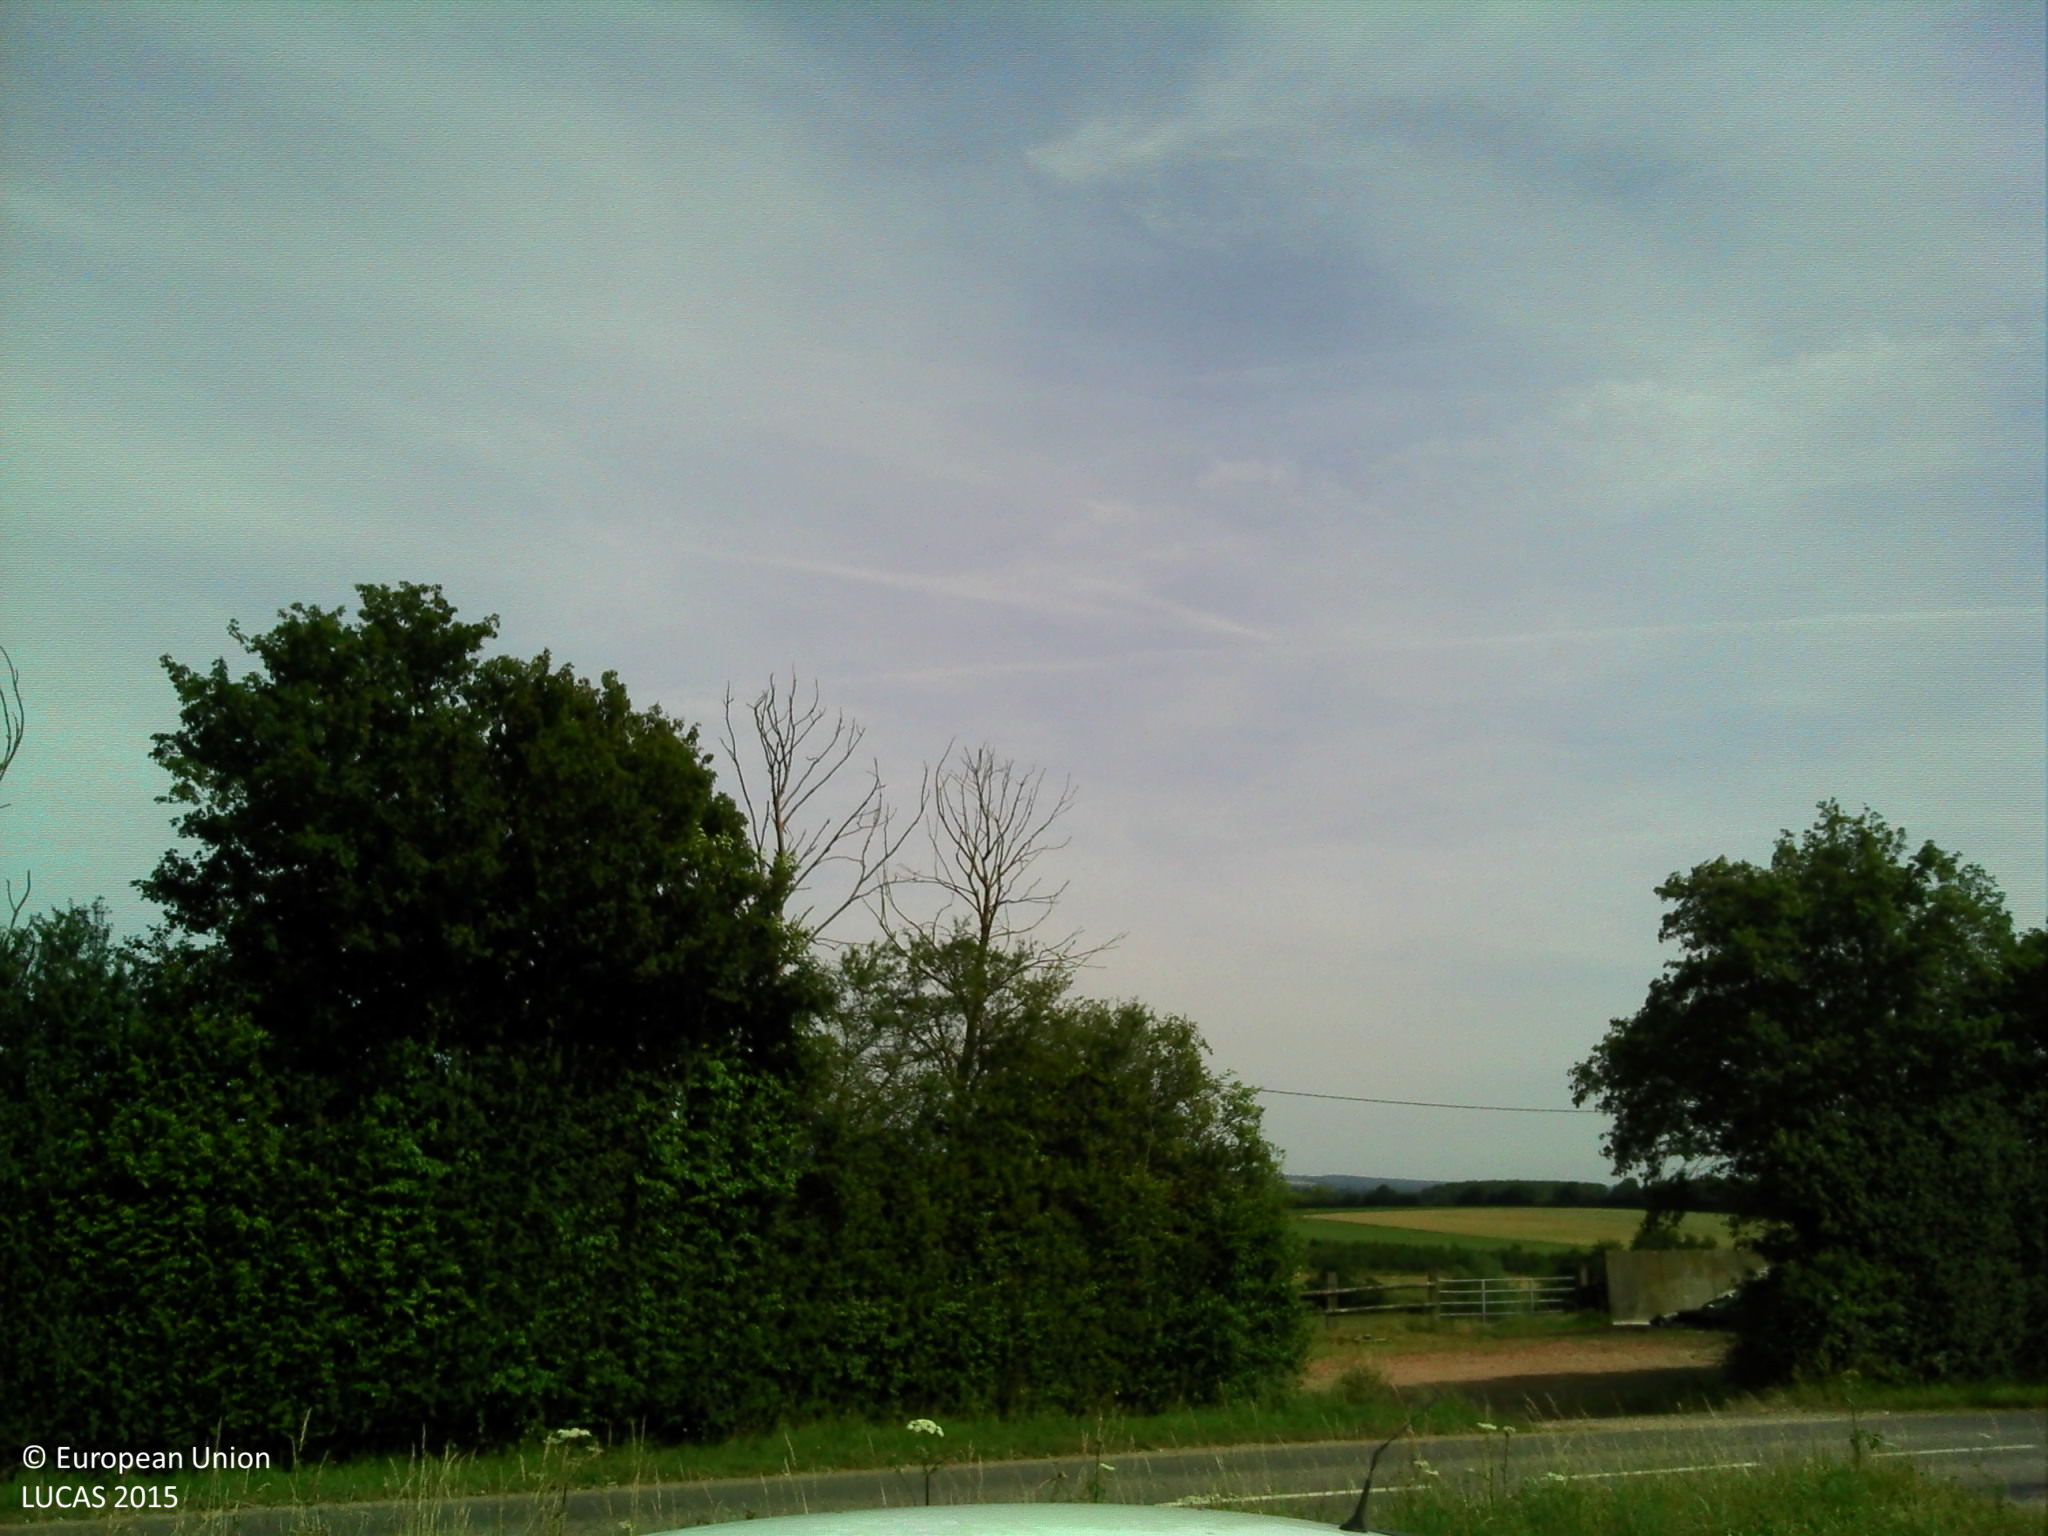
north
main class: Cropland
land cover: Maize
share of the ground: 25 - 50 %
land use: Agriculture (excluding fallow land and kitchen gardens)
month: June
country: FR
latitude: 48.4335
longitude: 0.1459
